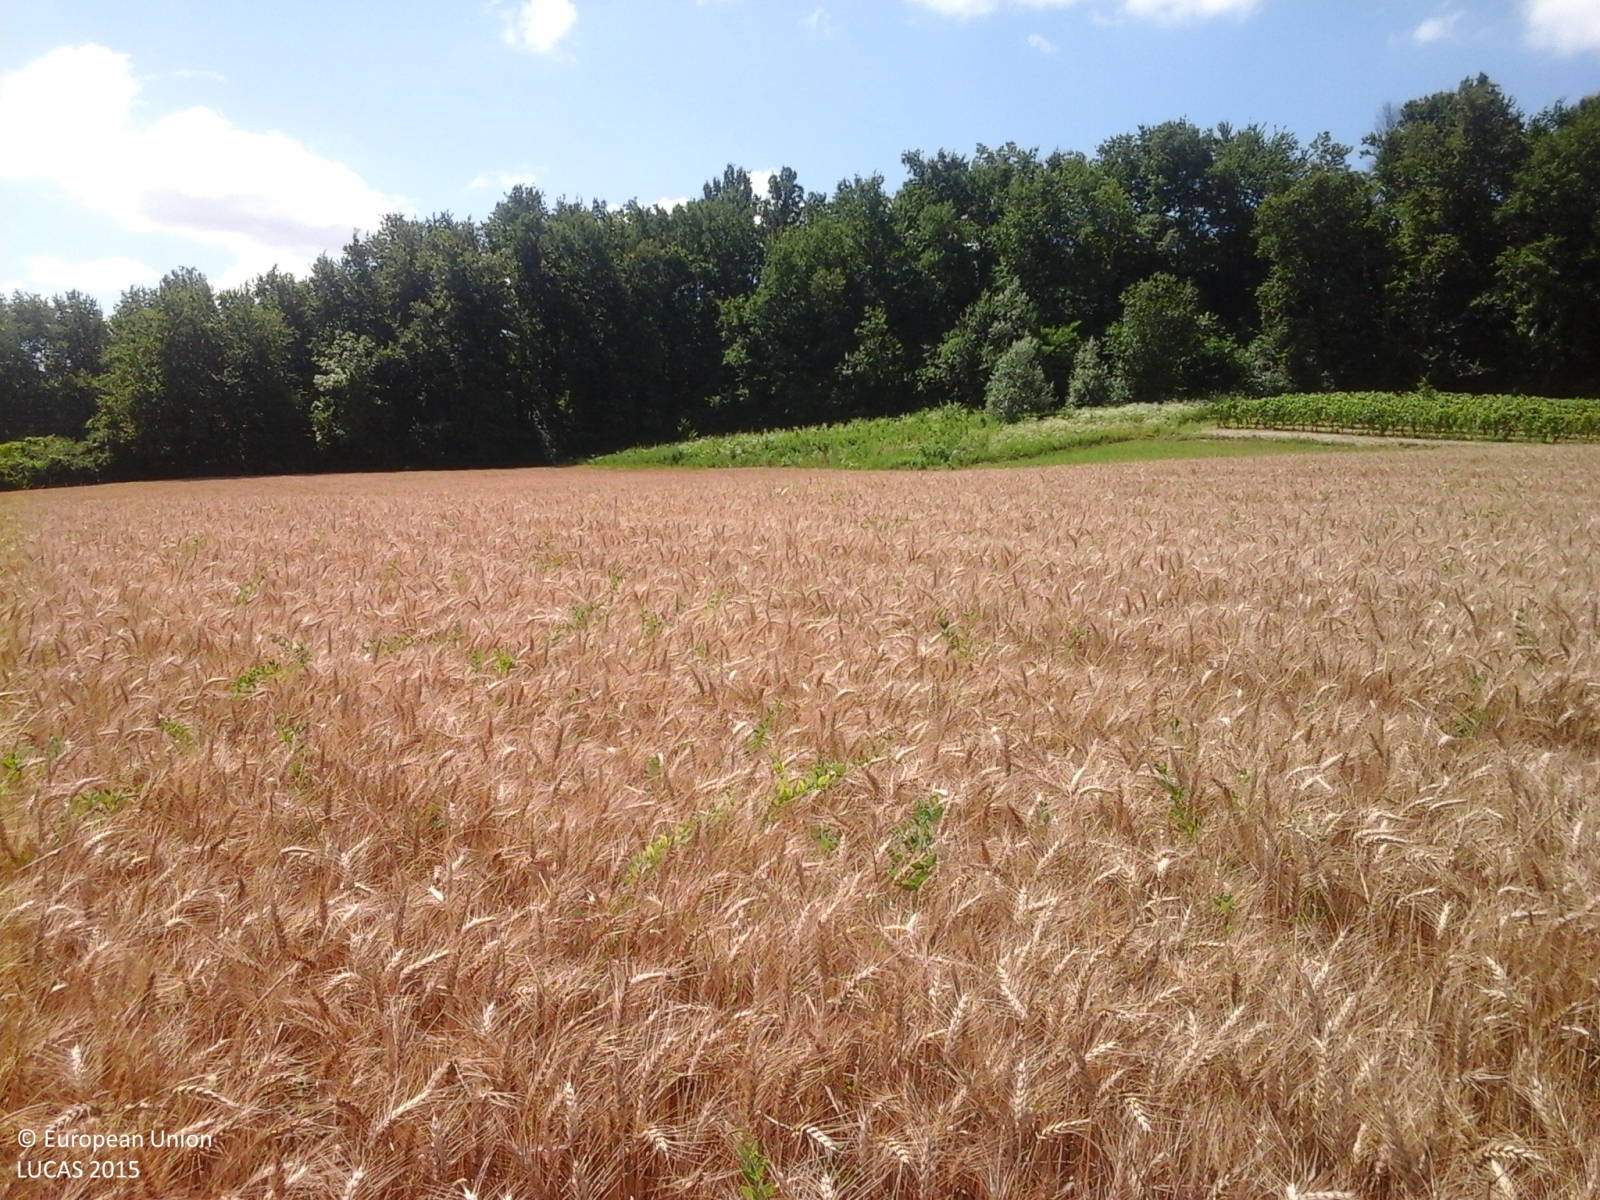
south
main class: Cropland
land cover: Common wheat
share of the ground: > 75 %
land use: Agriculture (excluding fallow land and kitchen gardens)
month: June
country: IT
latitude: 45.0595
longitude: 8.3902
